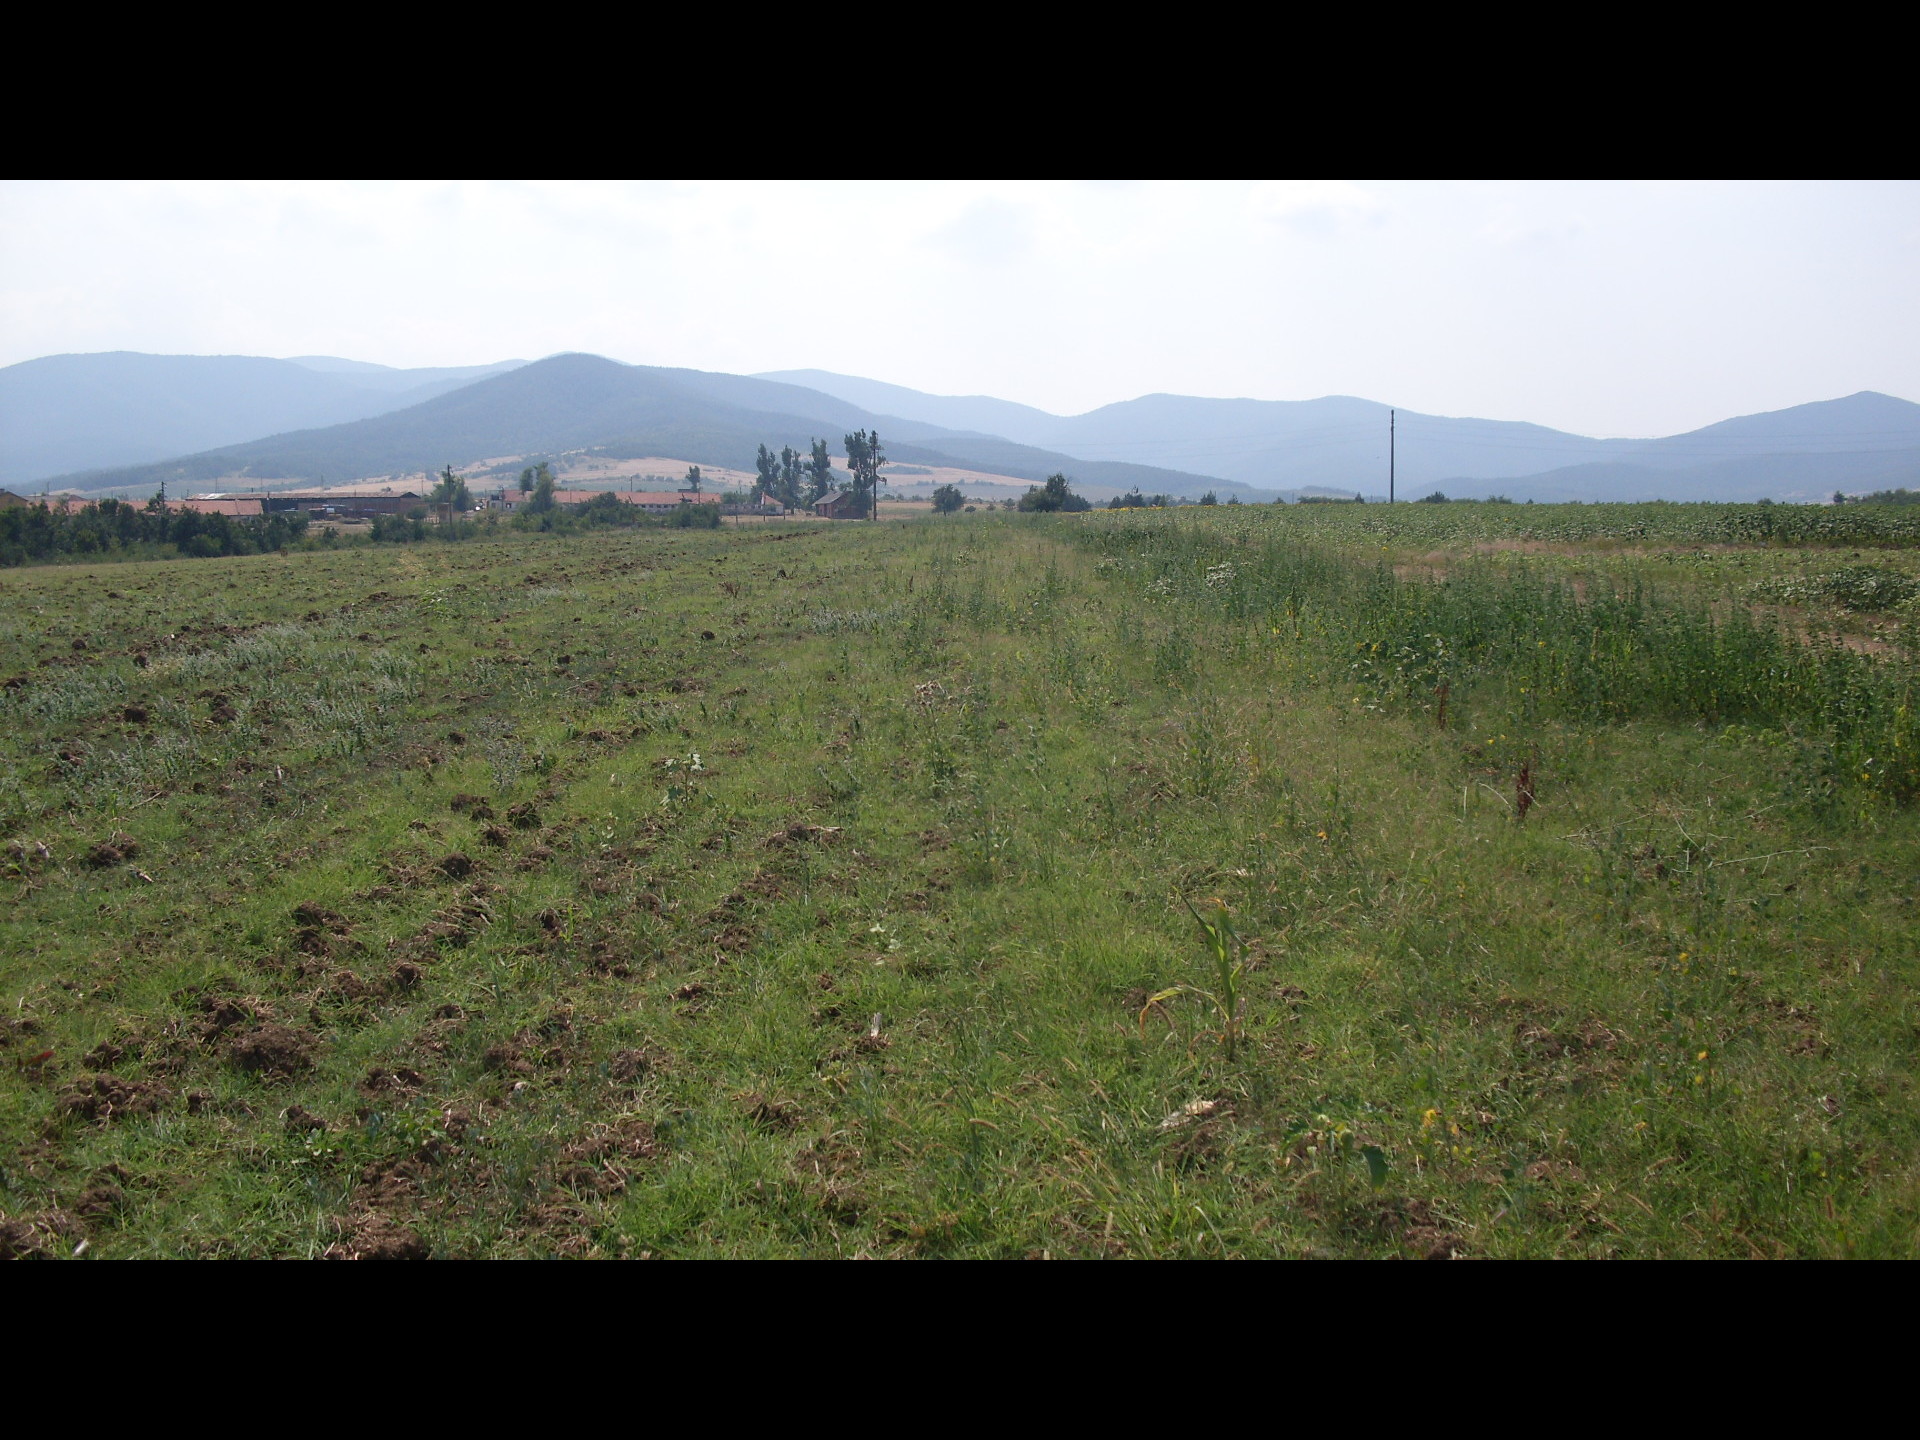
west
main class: Grassland
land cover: Spontaneously vegetated surfaces
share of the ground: > 75 %
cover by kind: herbaceous plants 100 %
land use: Agriculture (excluding fallow land and kitchen gardens)
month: July
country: BG
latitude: 43.7568
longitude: 22.4899
